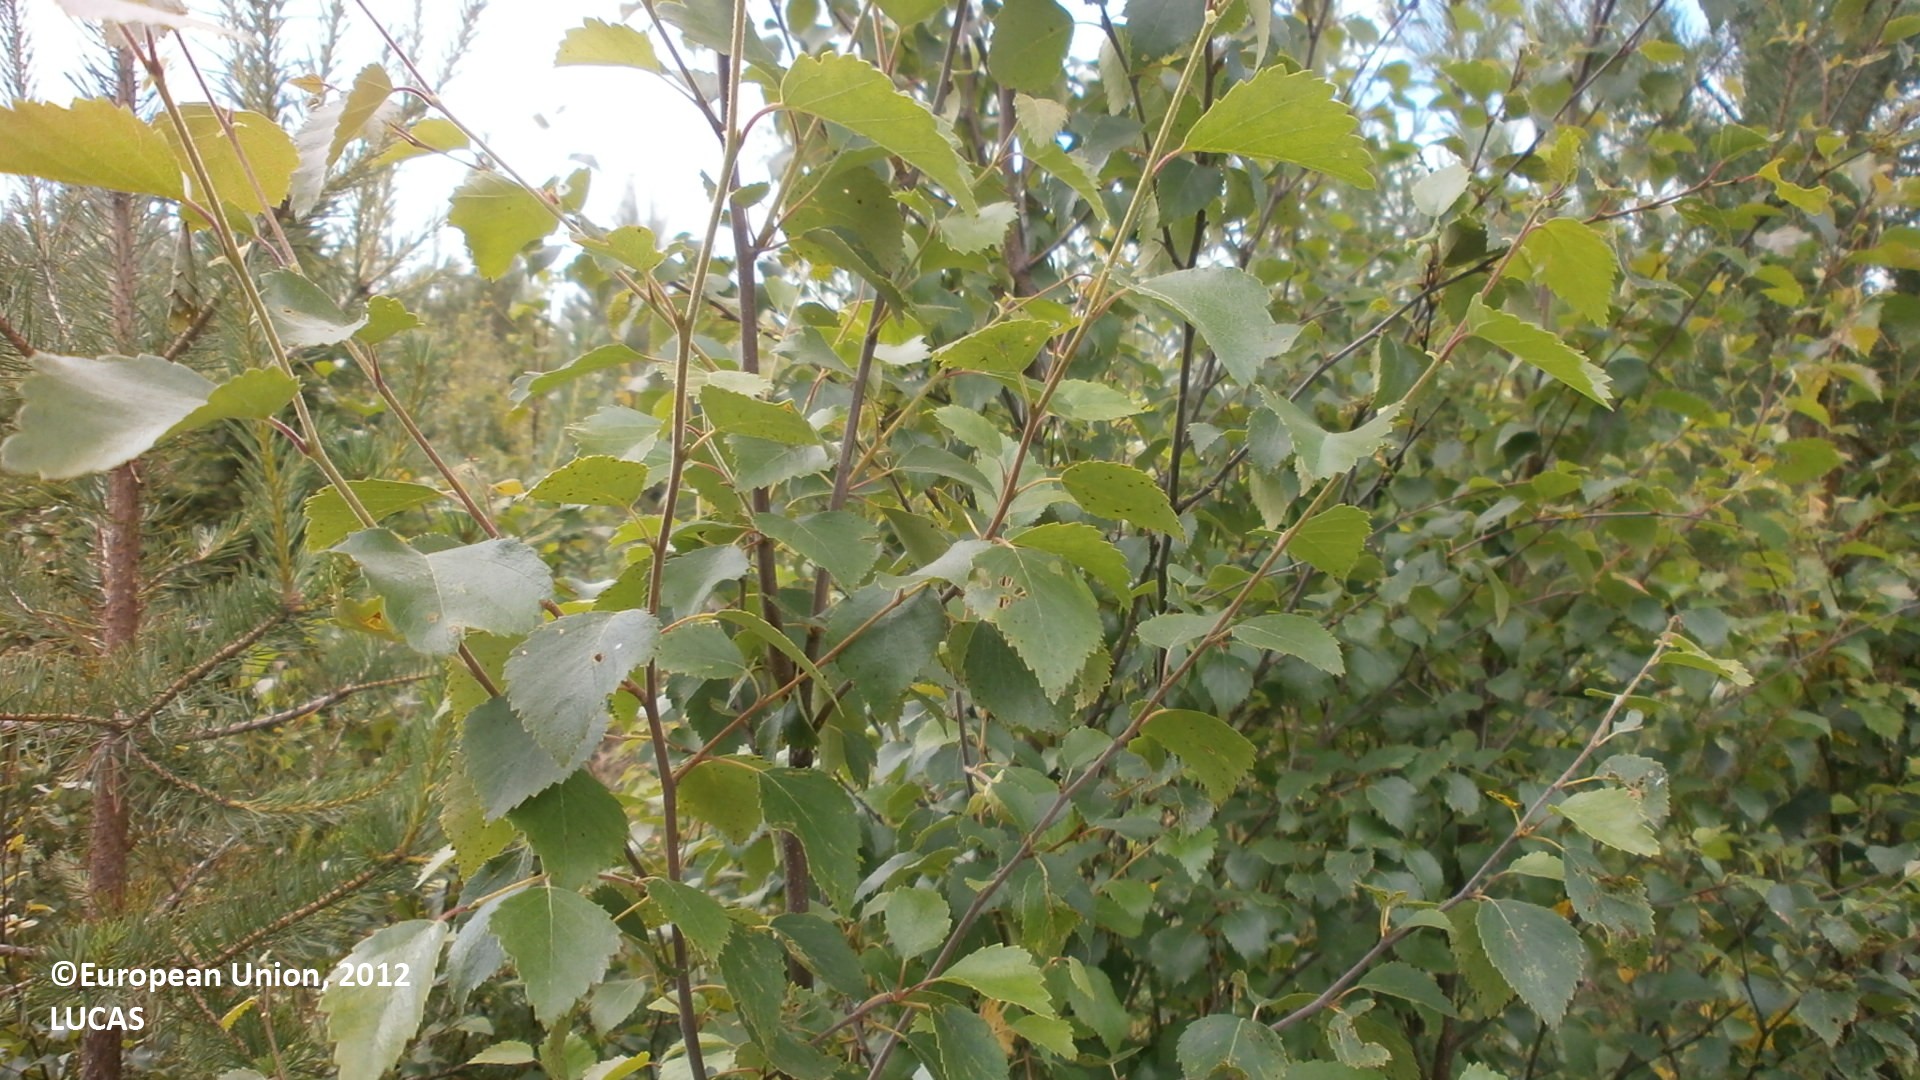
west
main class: Woodland
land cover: Pine dominated mixed woodland
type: boreal forest
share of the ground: 50 - 75 %
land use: Forestry
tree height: > 5 m
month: July
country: FI
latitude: 64.0134
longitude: 23.7873
